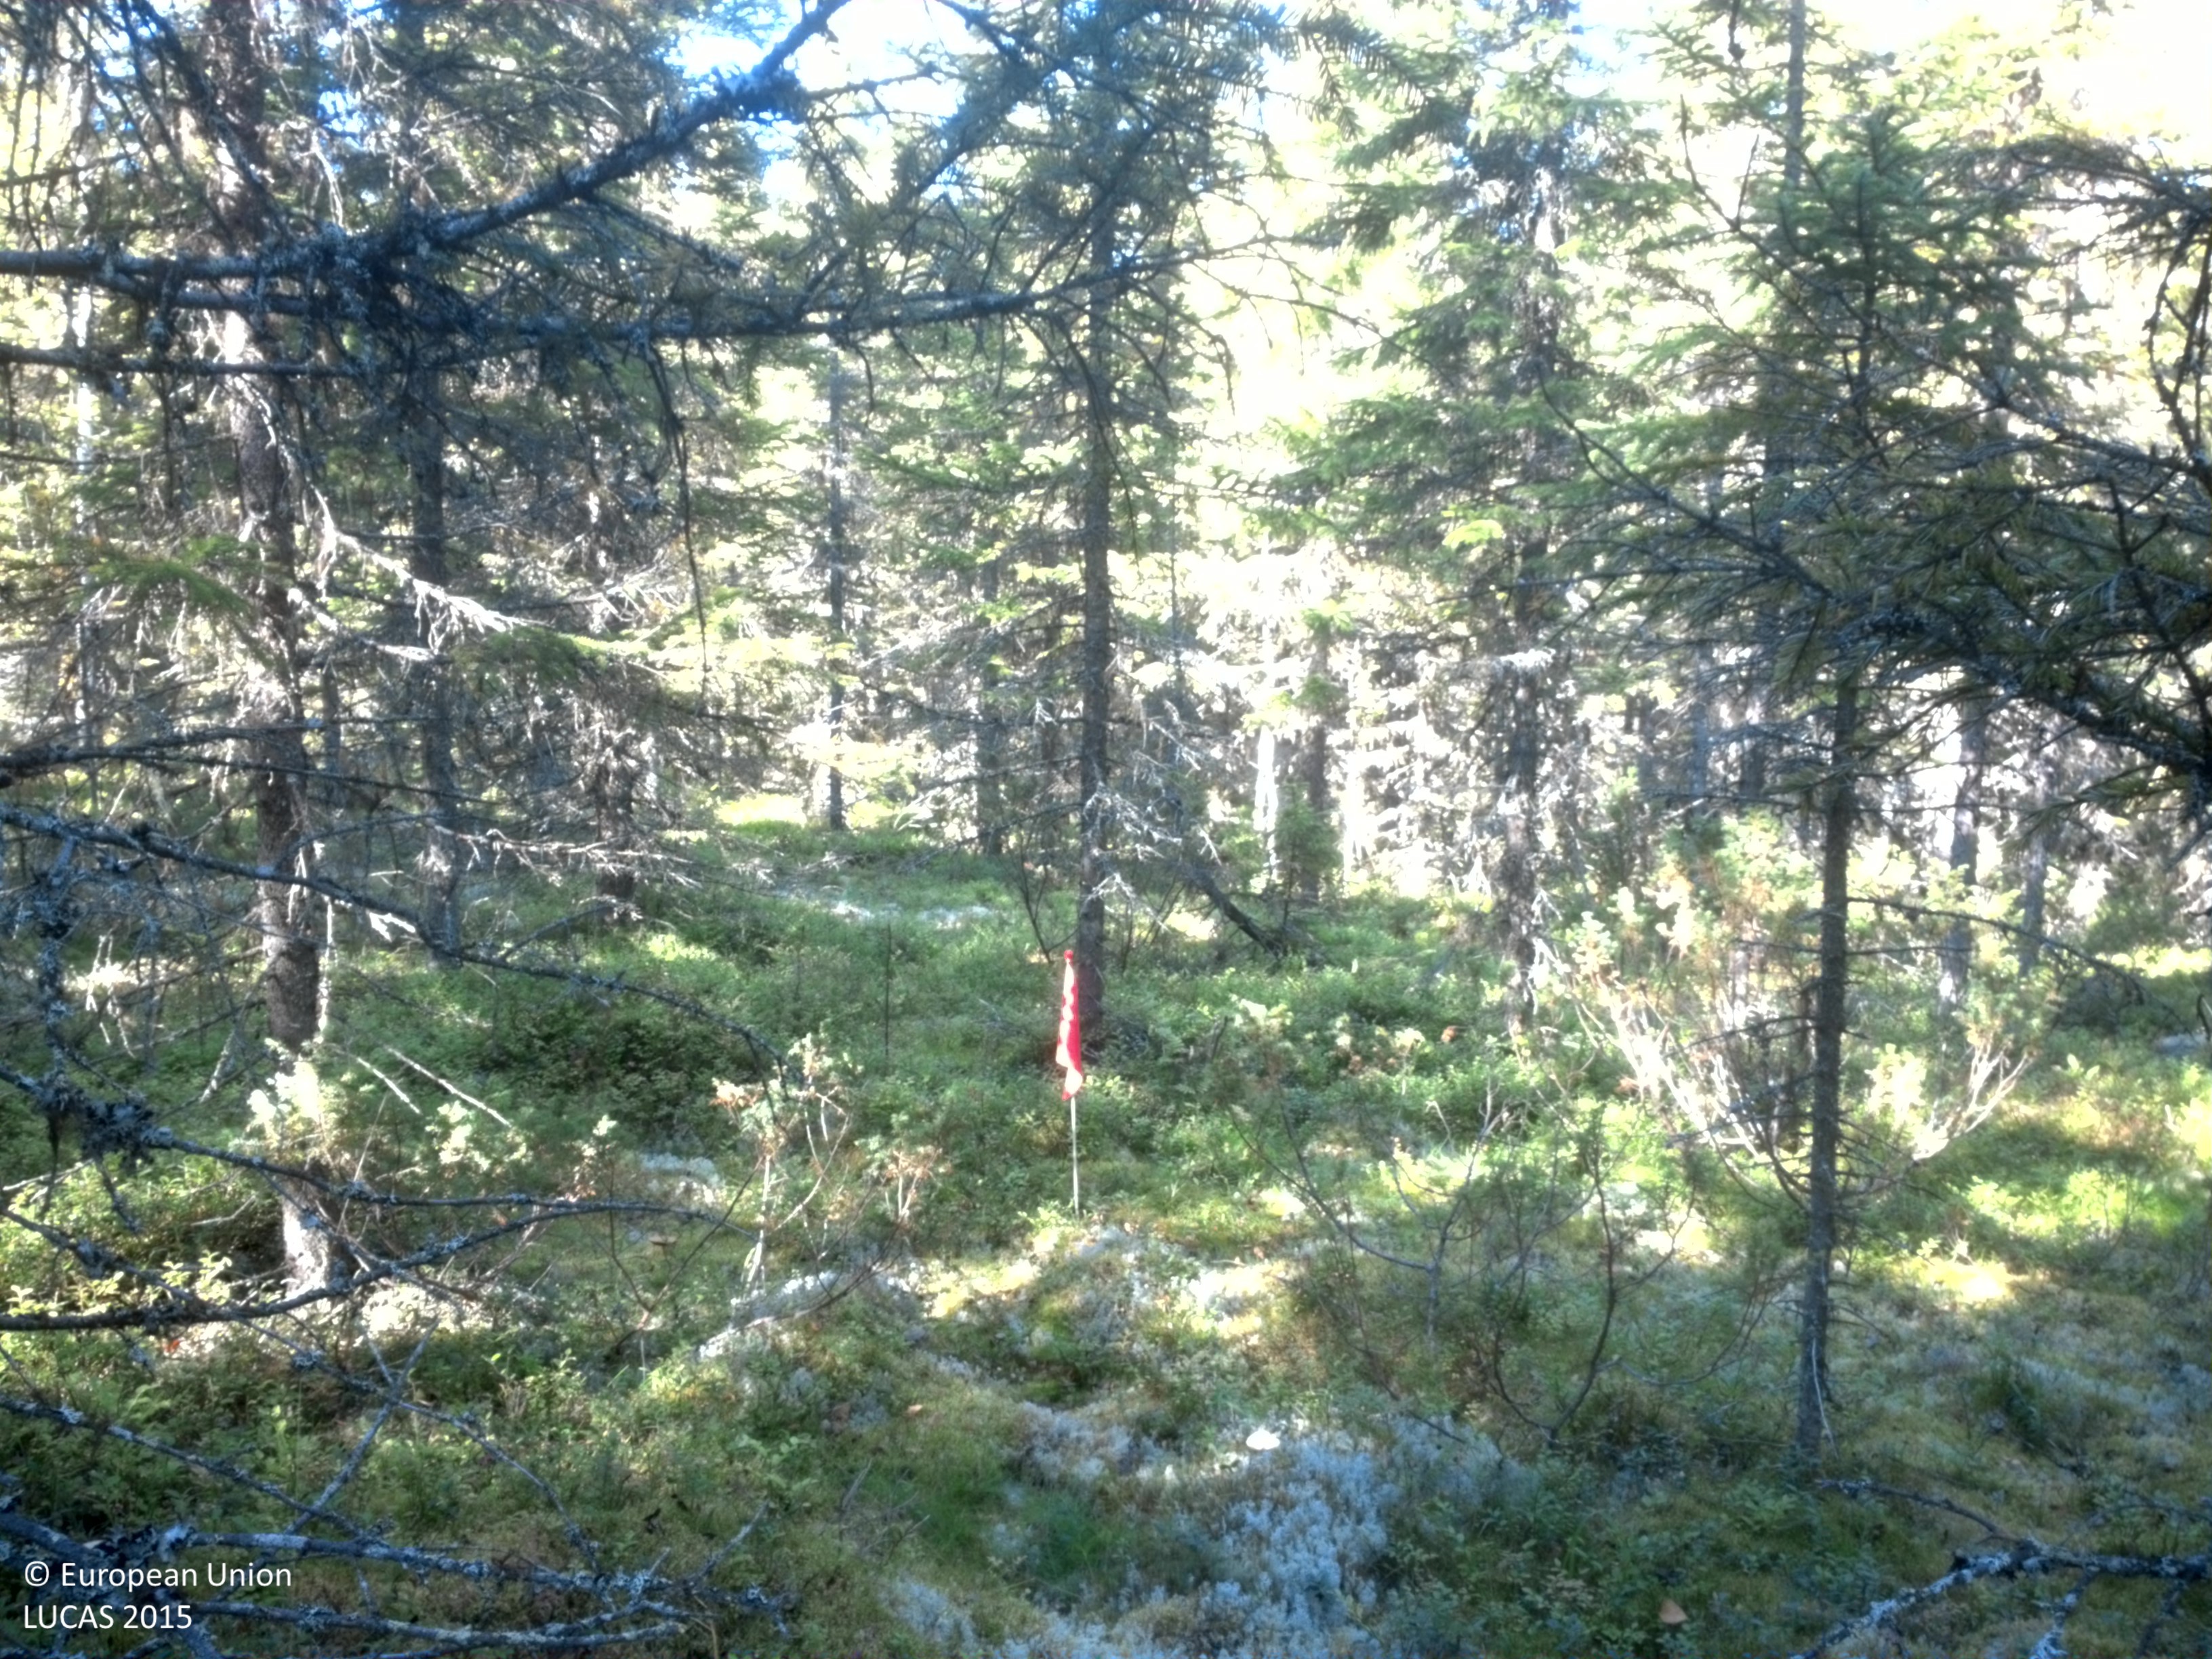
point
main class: Woodland
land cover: Spruce dominated coniferous woodland
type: boreal forest
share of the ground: 50 - 75 %
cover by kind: coniferous forest trees 65 %, shrubs 25 %, lichens and mosses 10 %
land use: Forestry
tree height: > 5 m
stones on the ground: 25 - 50 %
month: September
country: SE
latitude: 64.2624
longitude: 19.7373
